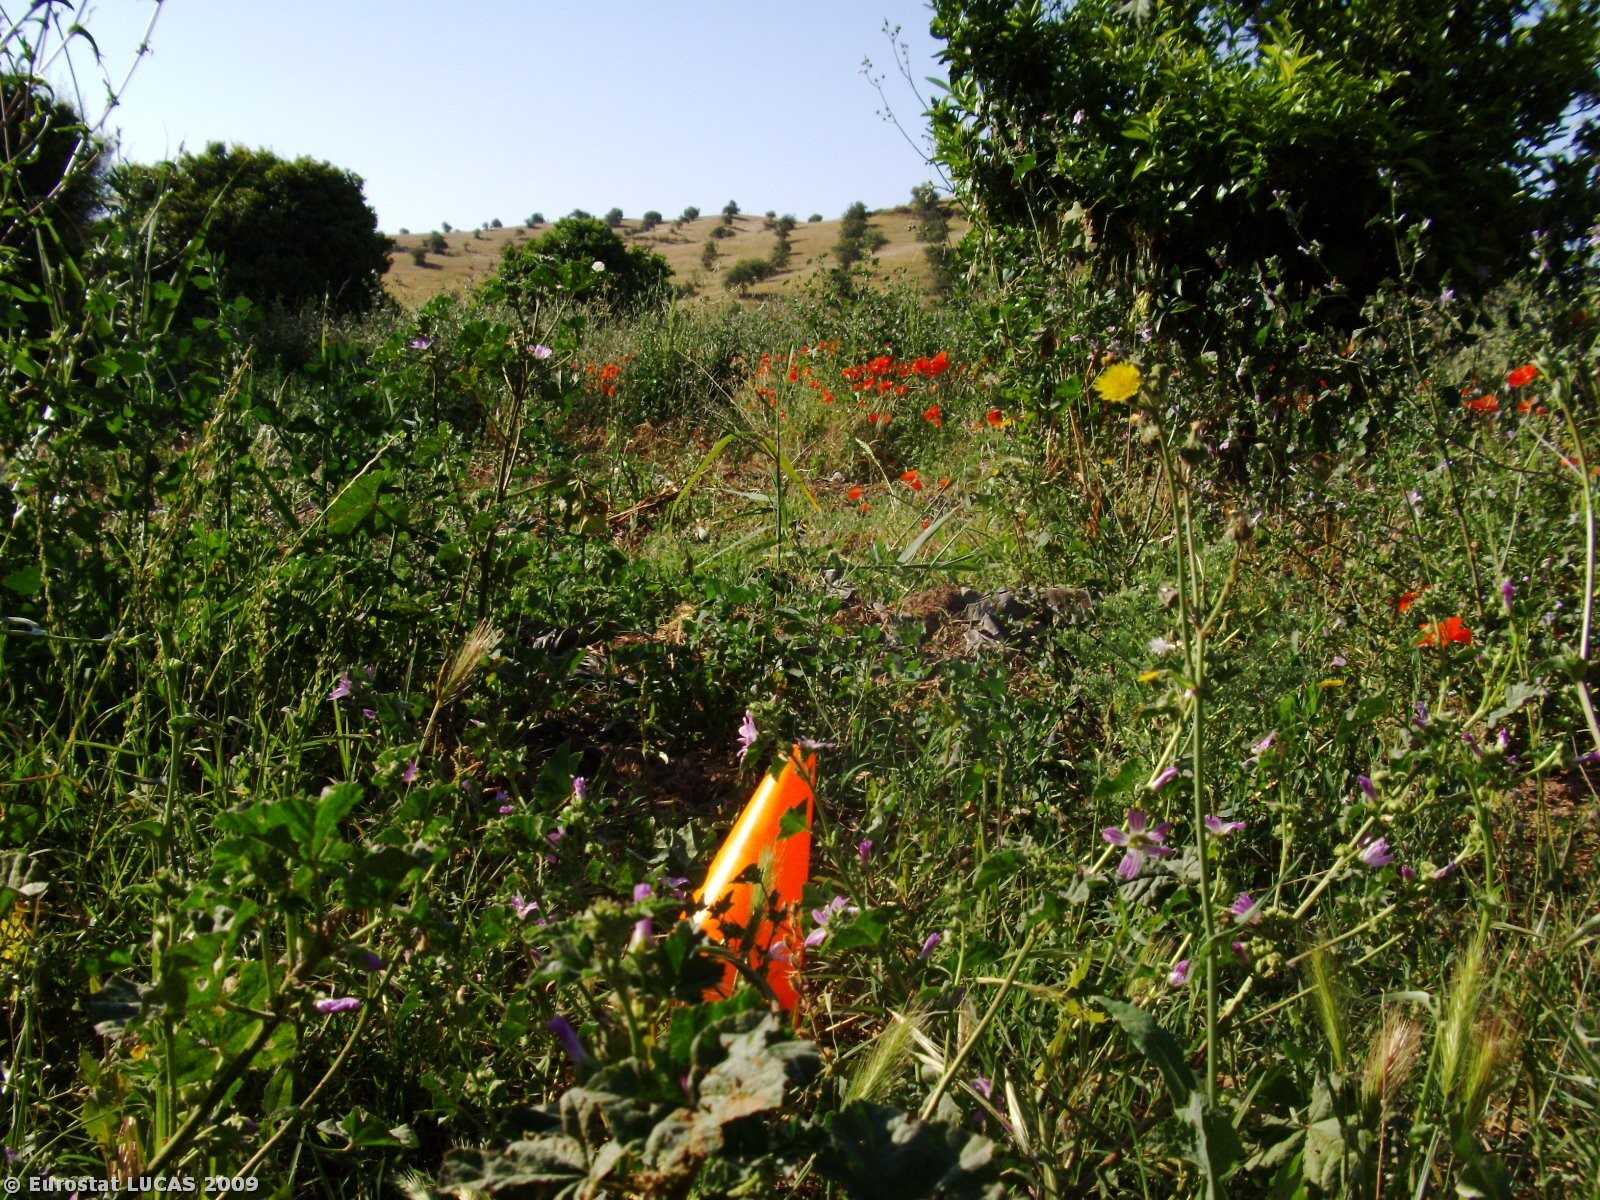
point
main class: Cropland
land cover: Oranges
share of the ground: 50 - 75 %
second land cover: Spontaneously vegetated surfaces
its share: 10 - 25 %
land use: Agriculture (excluding fallow land and kitchen gardens)
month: May
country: PT
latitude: 37.2634
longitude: -7.4703
